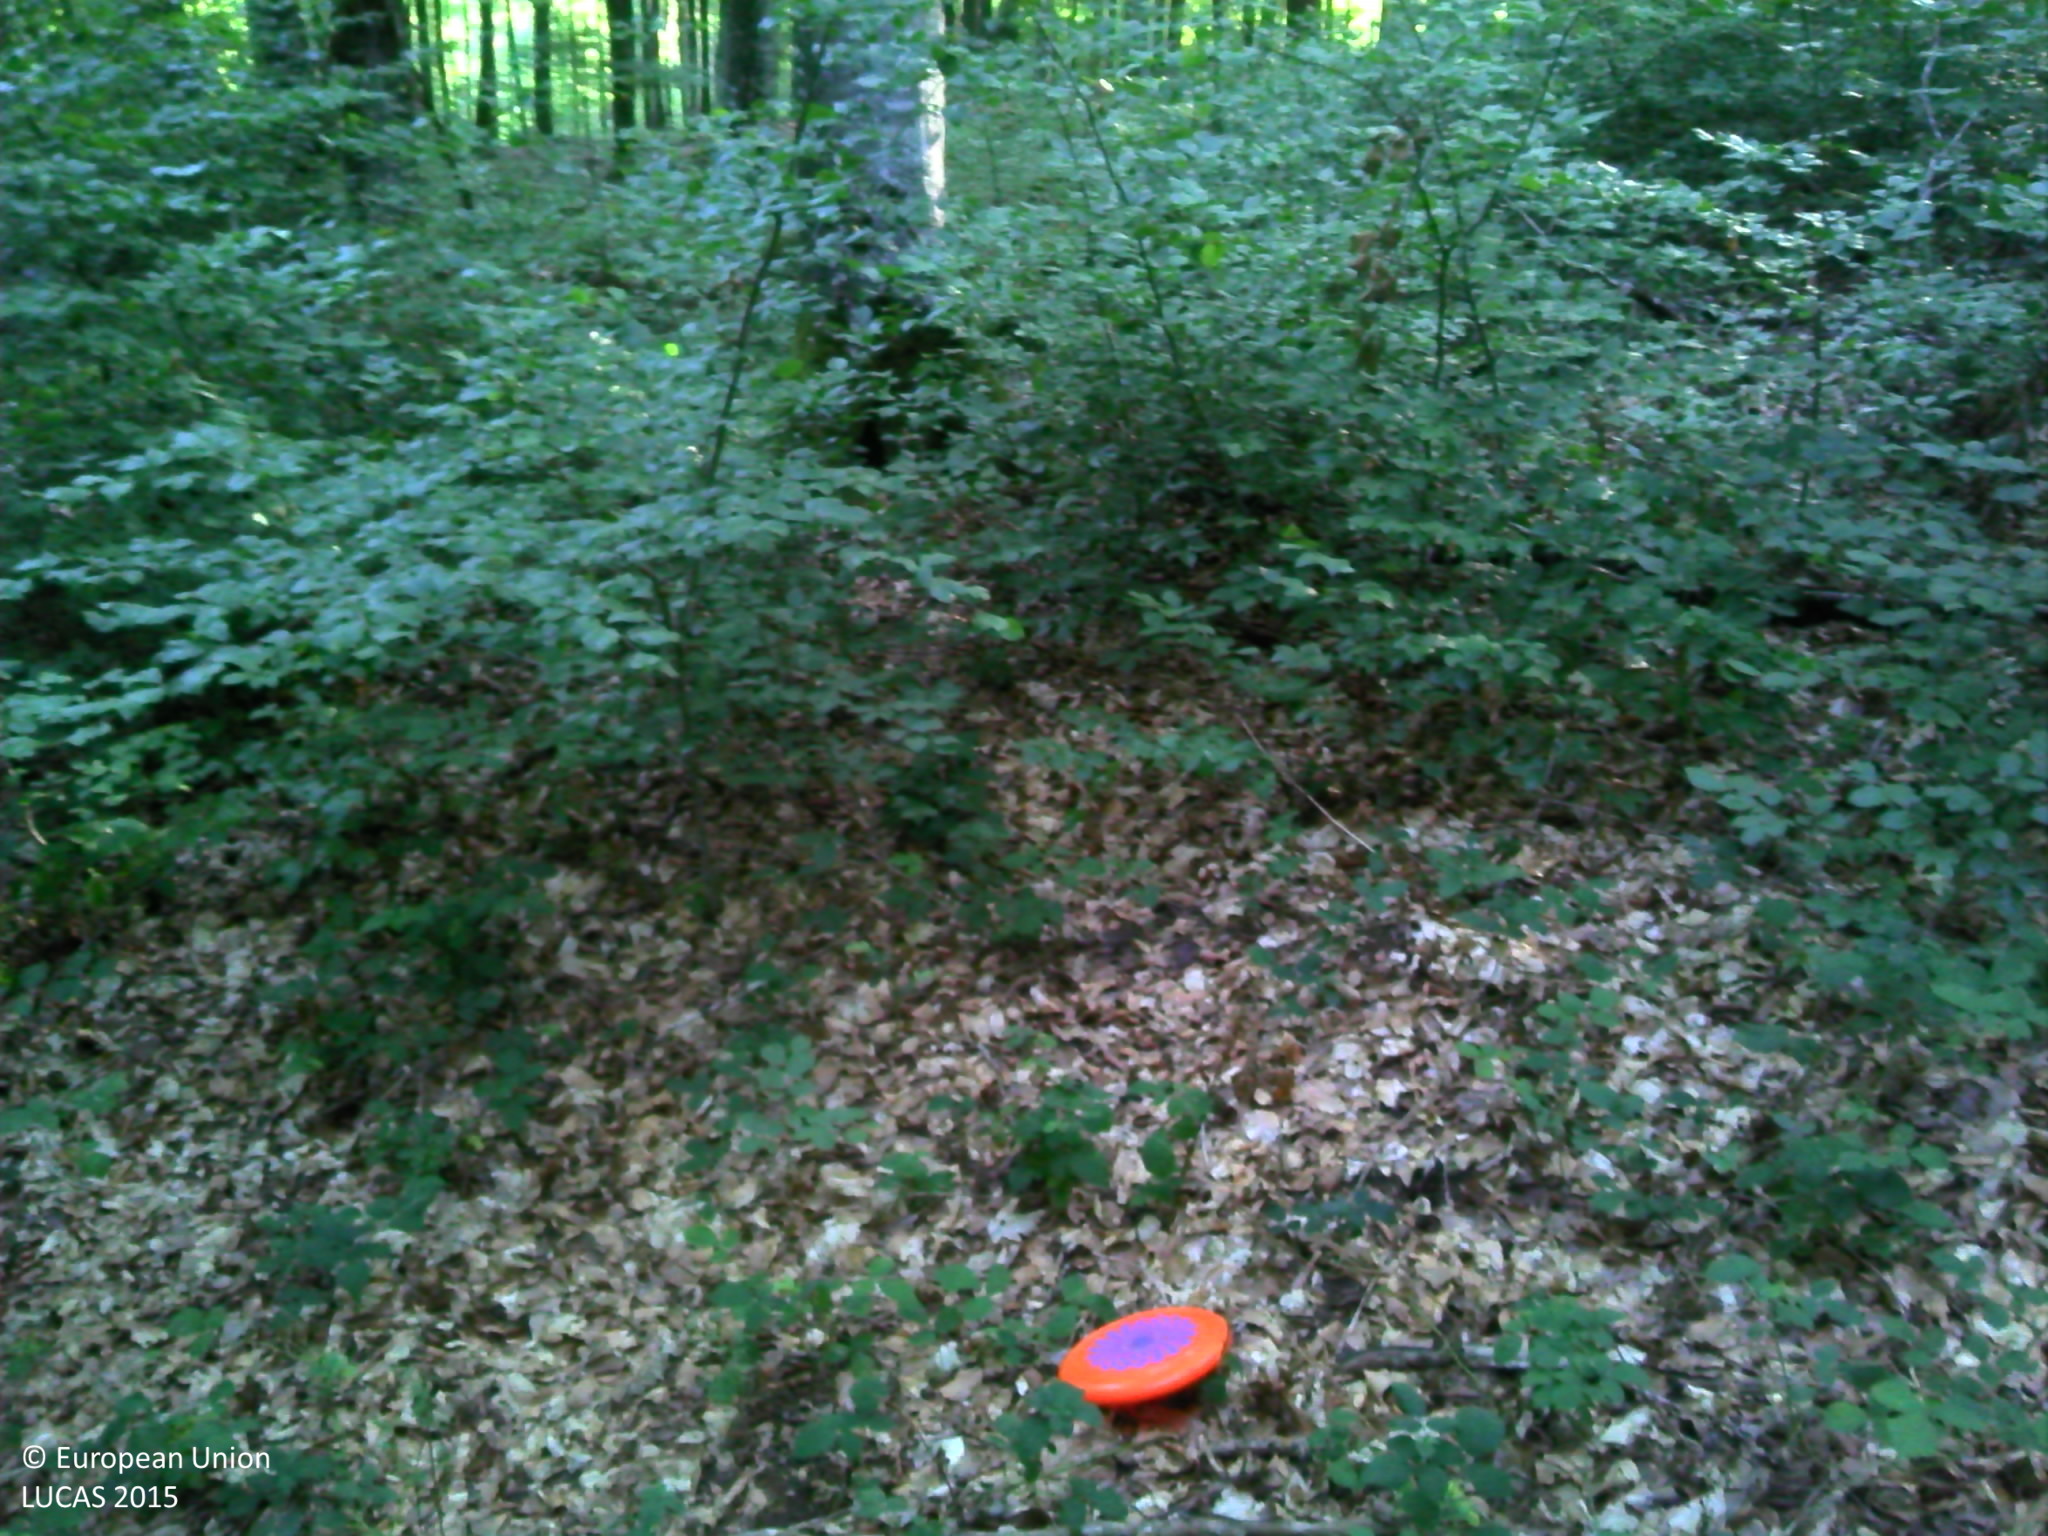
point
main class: Woodland
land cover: Broadleaved woodland
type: beech forest
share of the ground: > 75 %
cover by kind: broadleaved forest trees 75 %, herbaceous plants 25 %
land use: Forestry
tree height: > 5 m
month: August
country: FR
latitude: 46.8709
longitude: 4.3719
